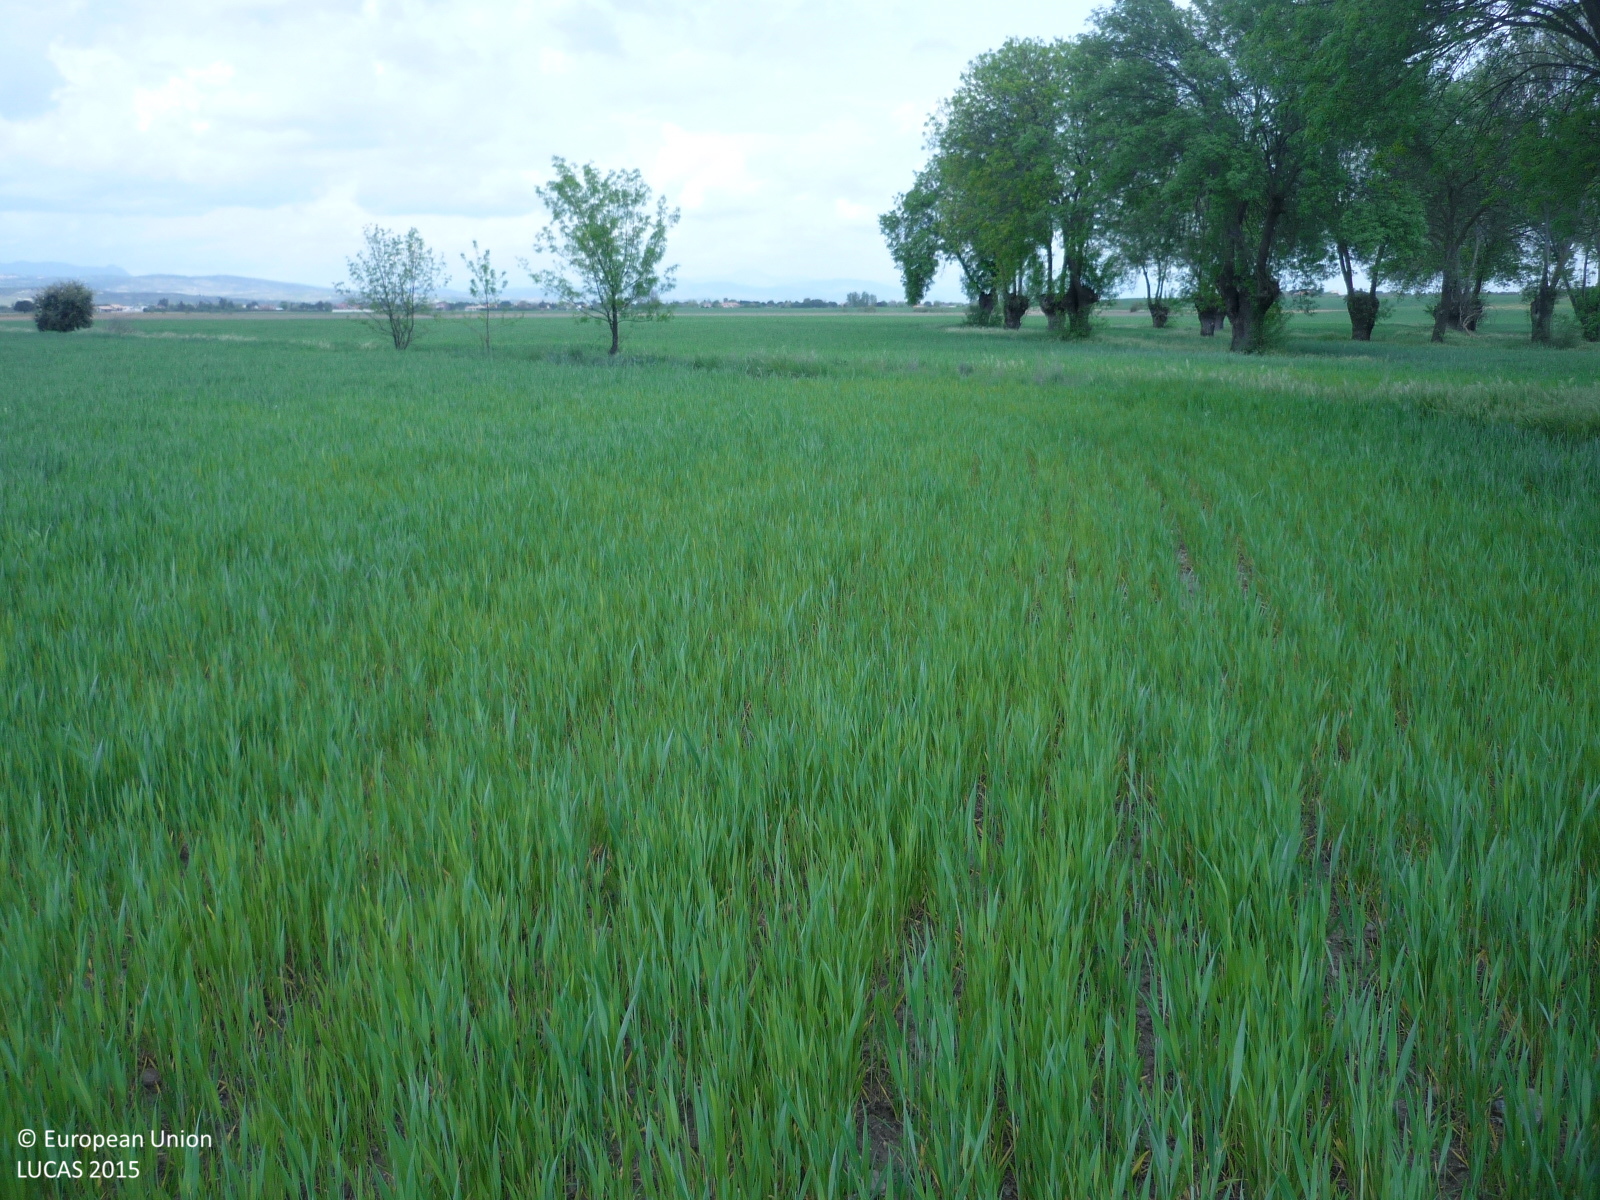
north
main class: Cropland
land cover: Common wheat
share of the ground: > 75 %
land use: Agriculture (excluding fallow land and kitchen gardens)
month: April
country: ES
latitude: 40.6615
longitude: -3.5344
